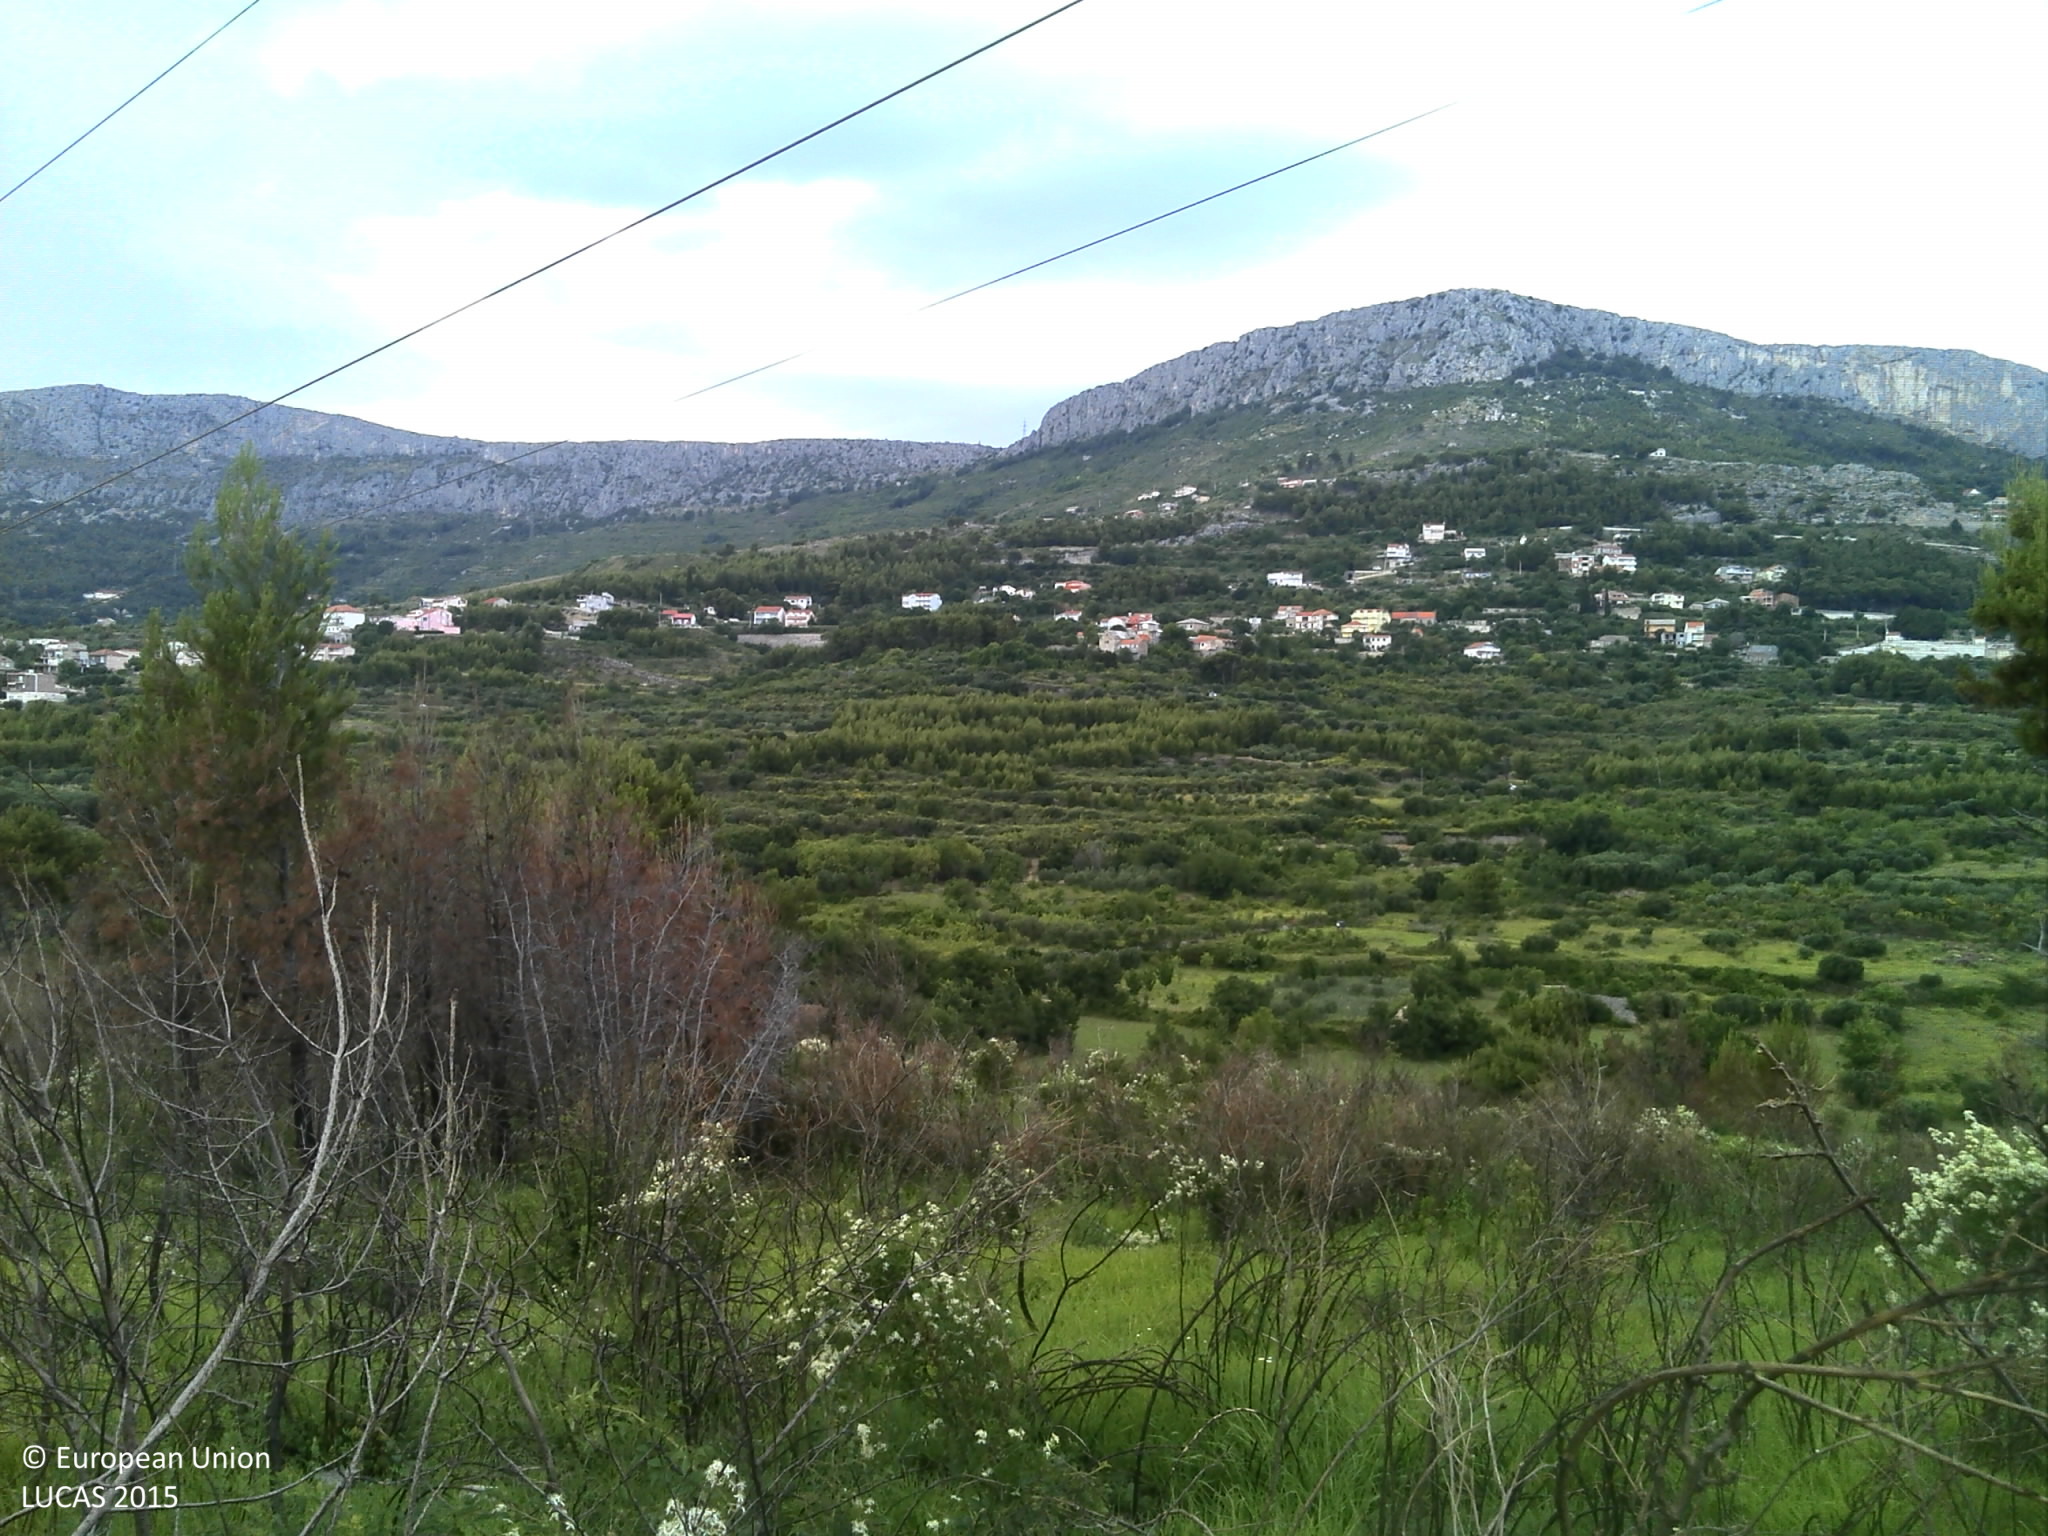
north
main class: Grassland
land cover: Spontaneously vegetated surfaces
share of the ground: > 75 %
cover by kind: herbaceous plants 80 %, shrubs 5 %, lichens and mosses 5 %, consolidated bare surface 5 %, unconsolidated bare surface 5 %
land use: Semi-natural and natural areas not in use
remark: Burnt area
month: June
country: HR
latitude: 43.5487
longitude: 16.5140
